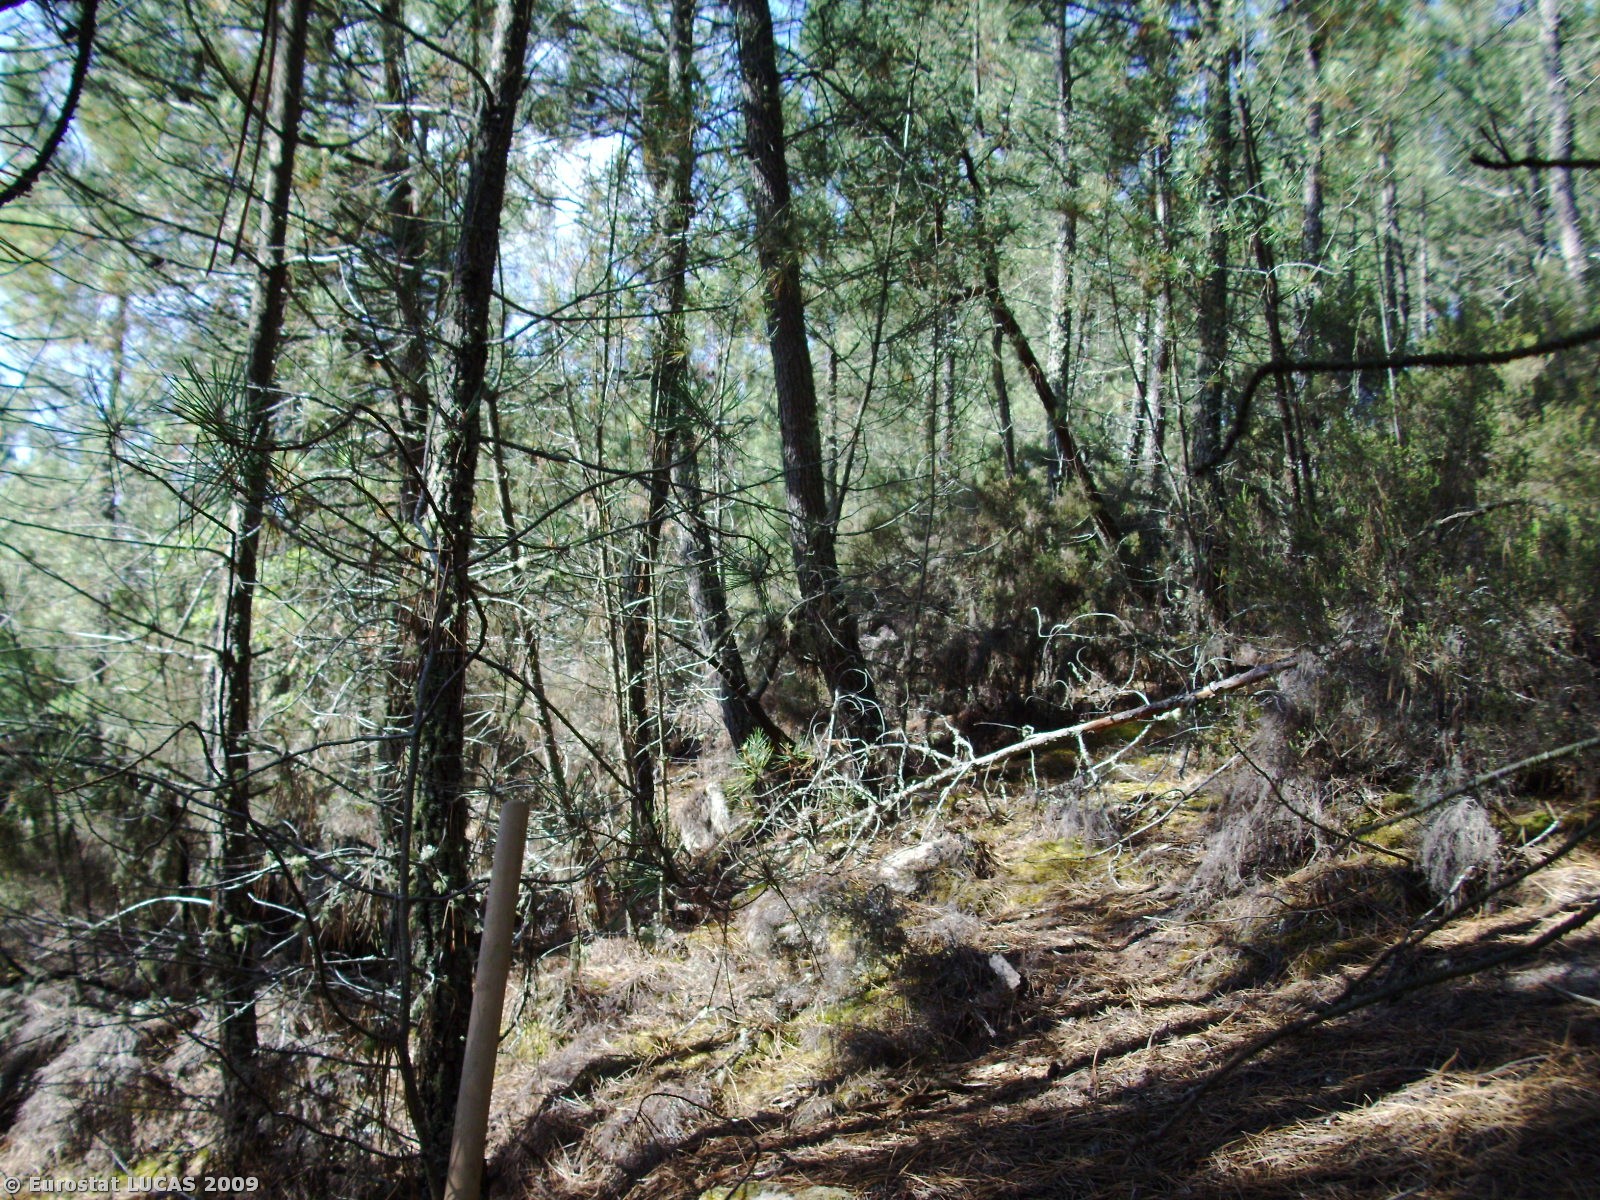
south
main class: Woodland
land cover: Coniferous woodland
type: coniferous forest of the mediterranean region
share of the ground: > 75 %
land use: Forestry
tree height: > 5 m
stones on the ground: 10 - 25 %
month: July
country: PT
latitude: 41.0141
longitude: -7.7607
